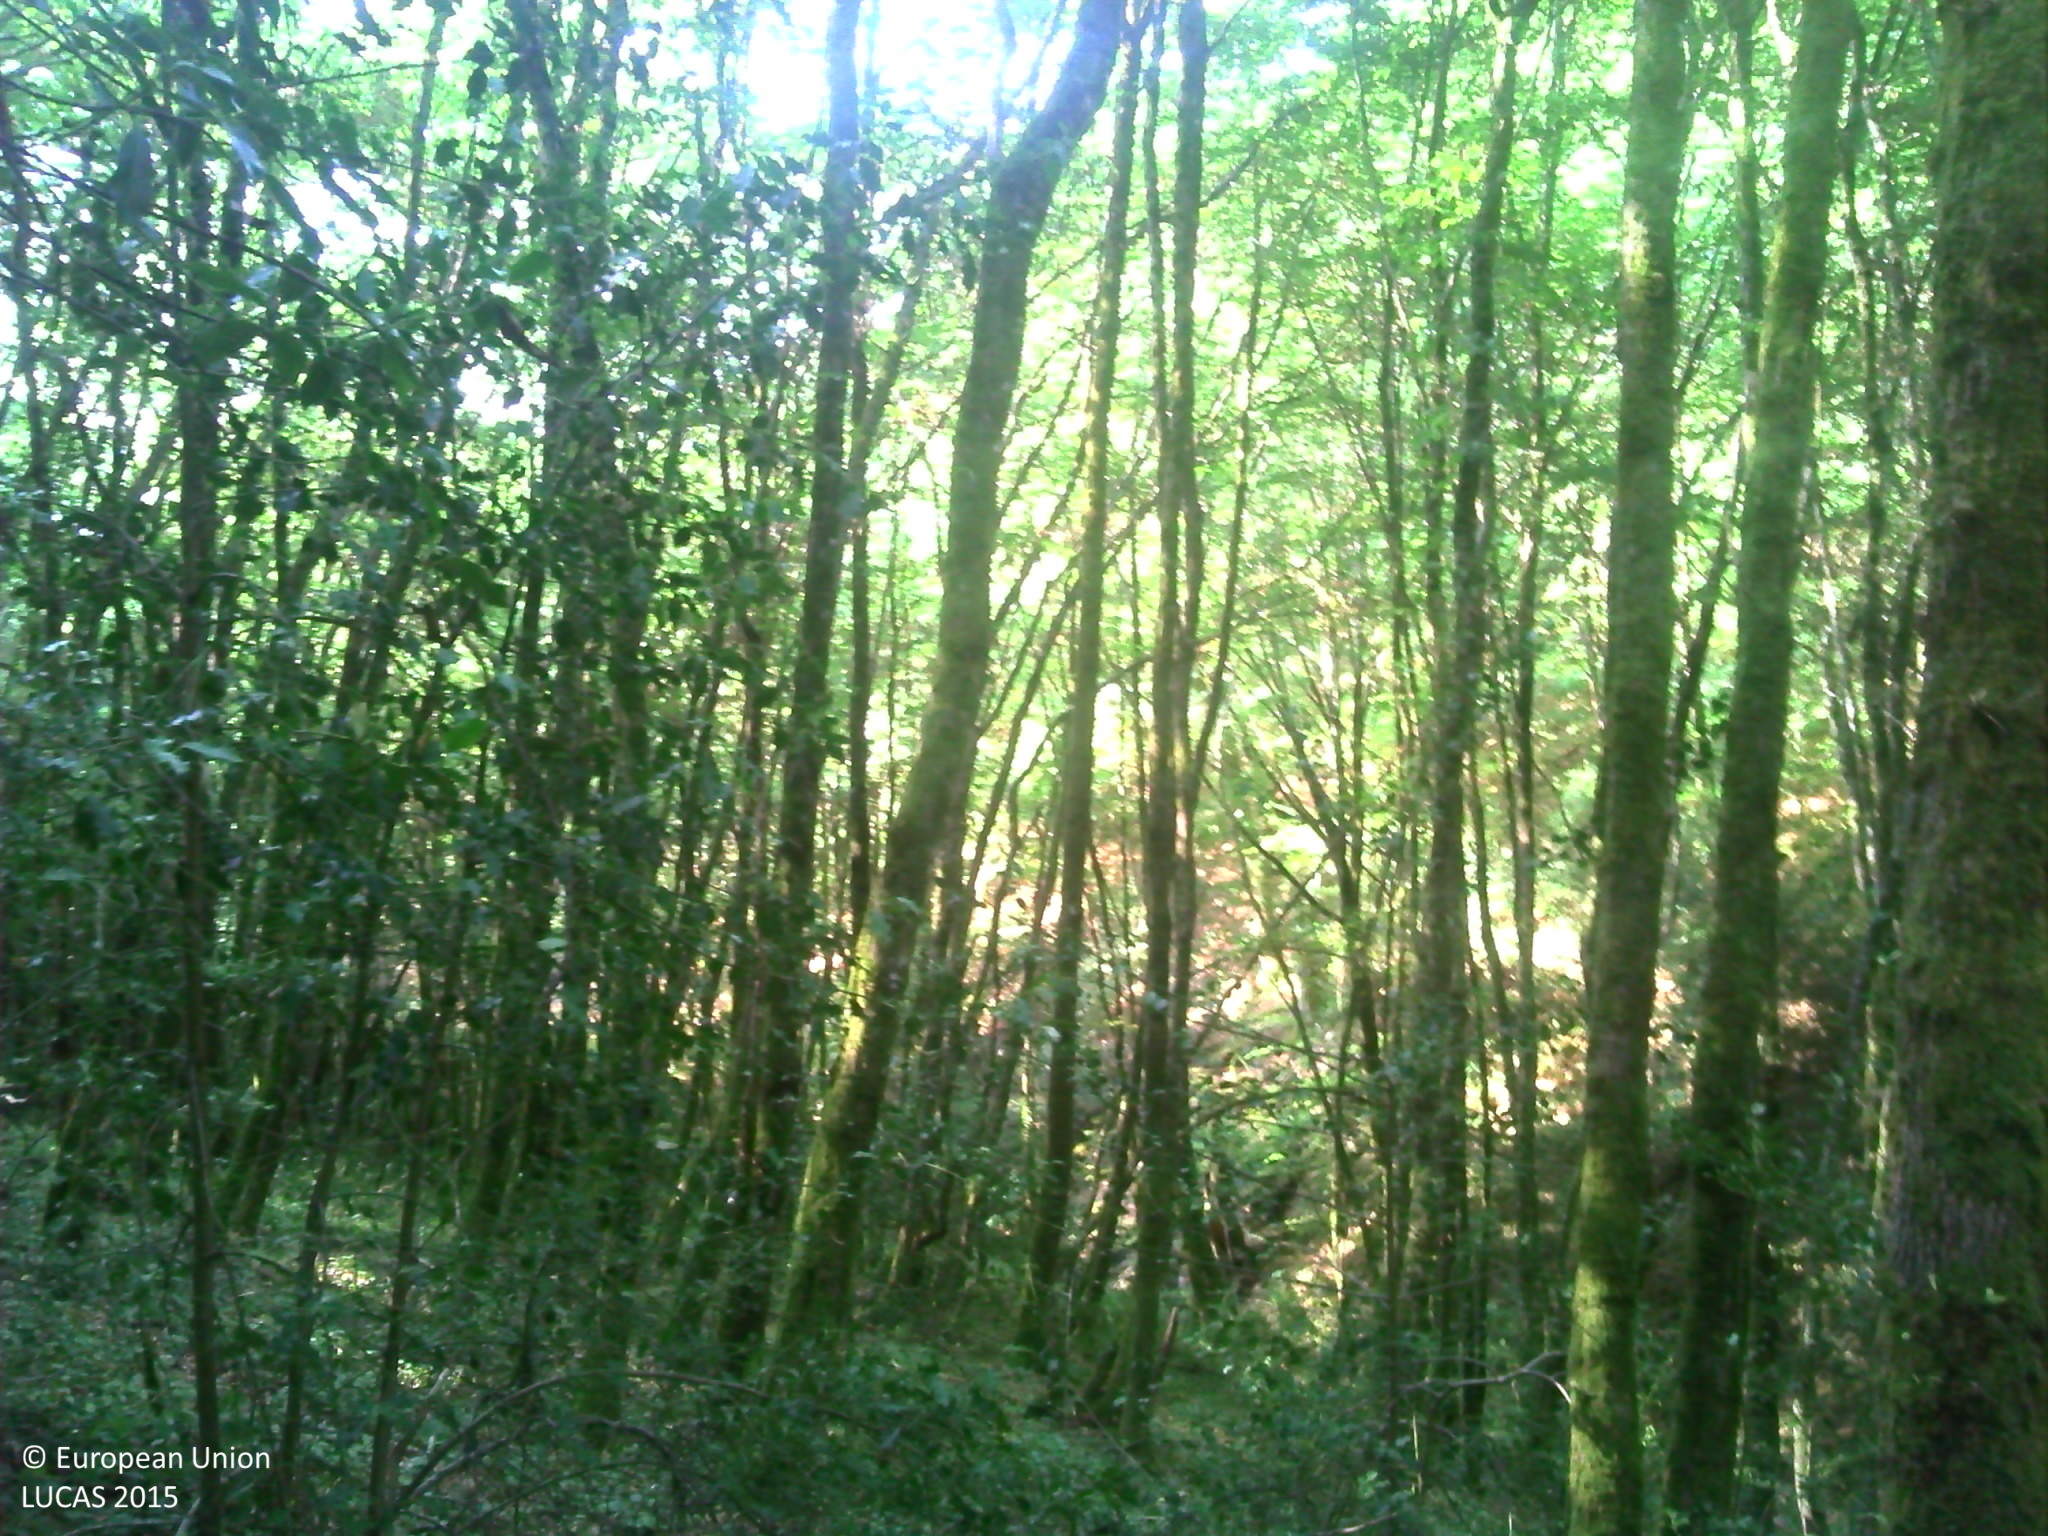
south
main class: Woodland
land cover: Broadleaved woodland
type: mesophytic deciduous forest
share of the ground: 50 - 75 %
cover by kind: broadleaved forest trees 80 %, herbaceous plants 20 %
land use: Forestry
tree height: > 5 m
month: August
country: FR
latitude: 45.3690
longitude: 1.8372
